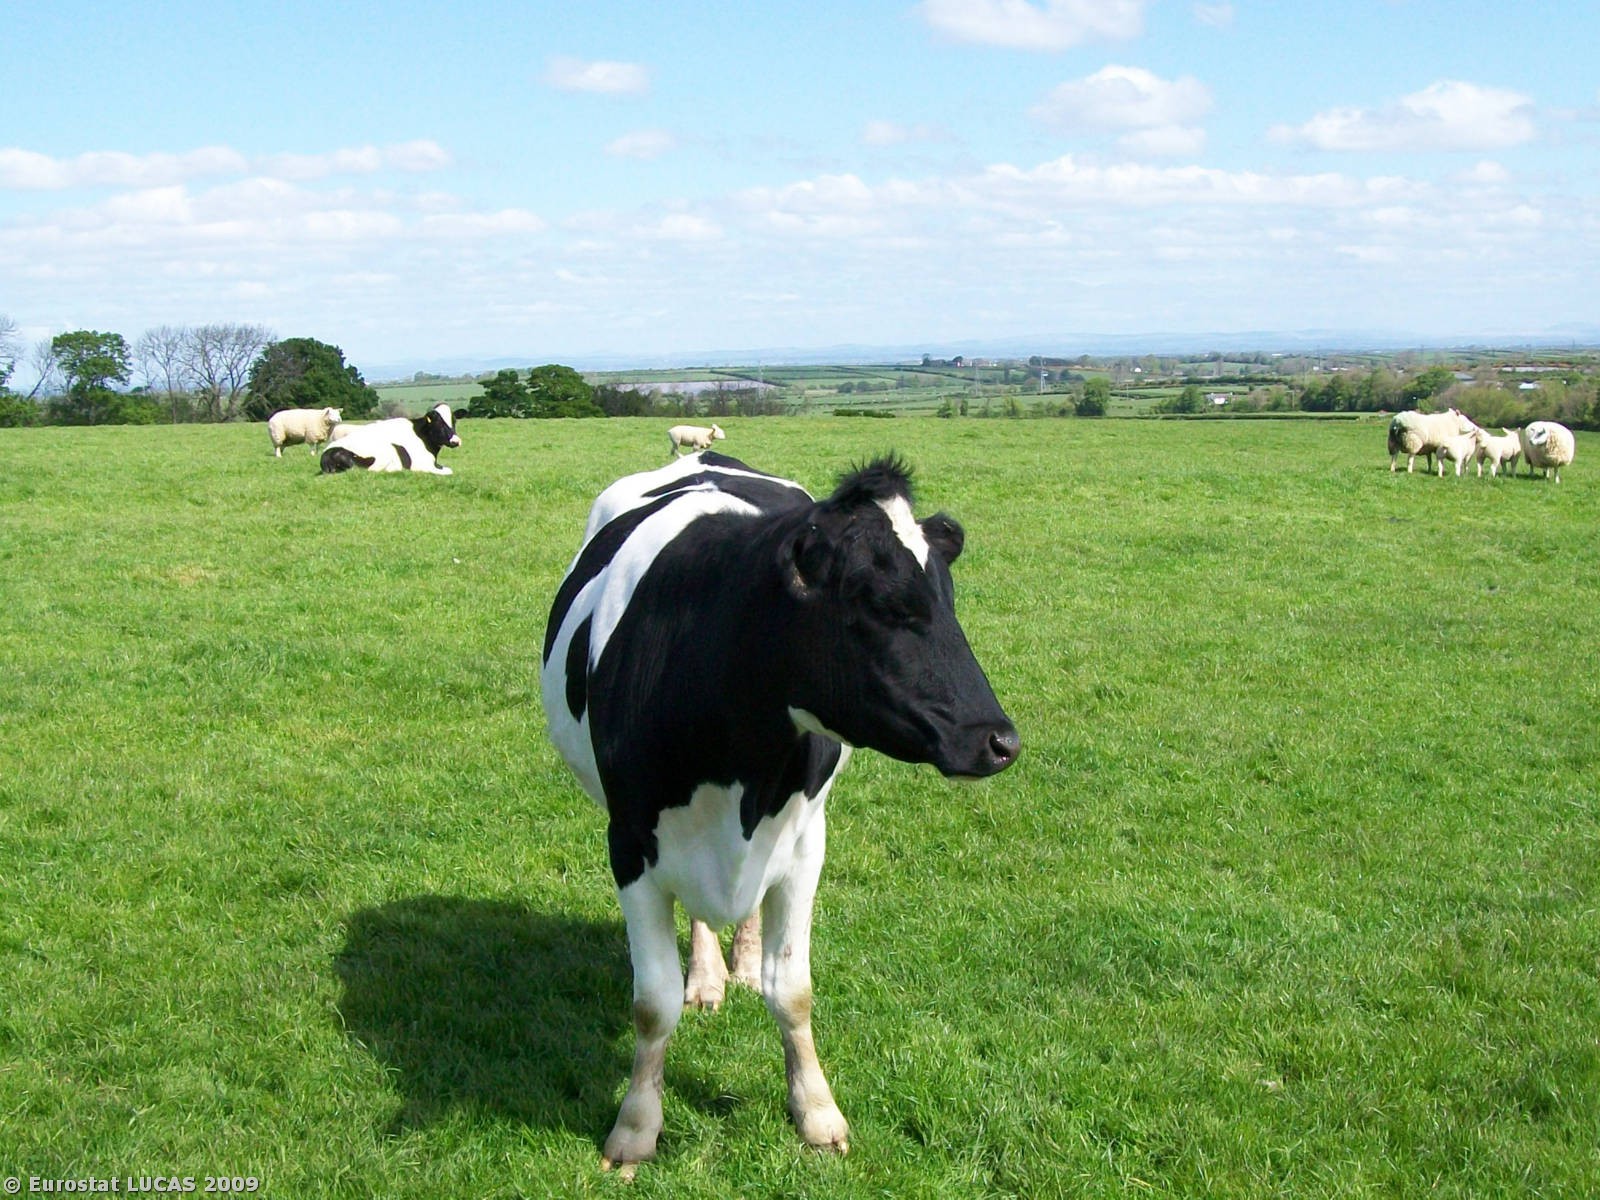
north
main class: Grassland
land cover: Grassland without tree/shrub cover
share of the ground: > 75 %
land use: Agriculture (excluding fallow land and kitchen gardens)
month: May
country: GB
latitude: 54.8063
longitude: -3.2224
